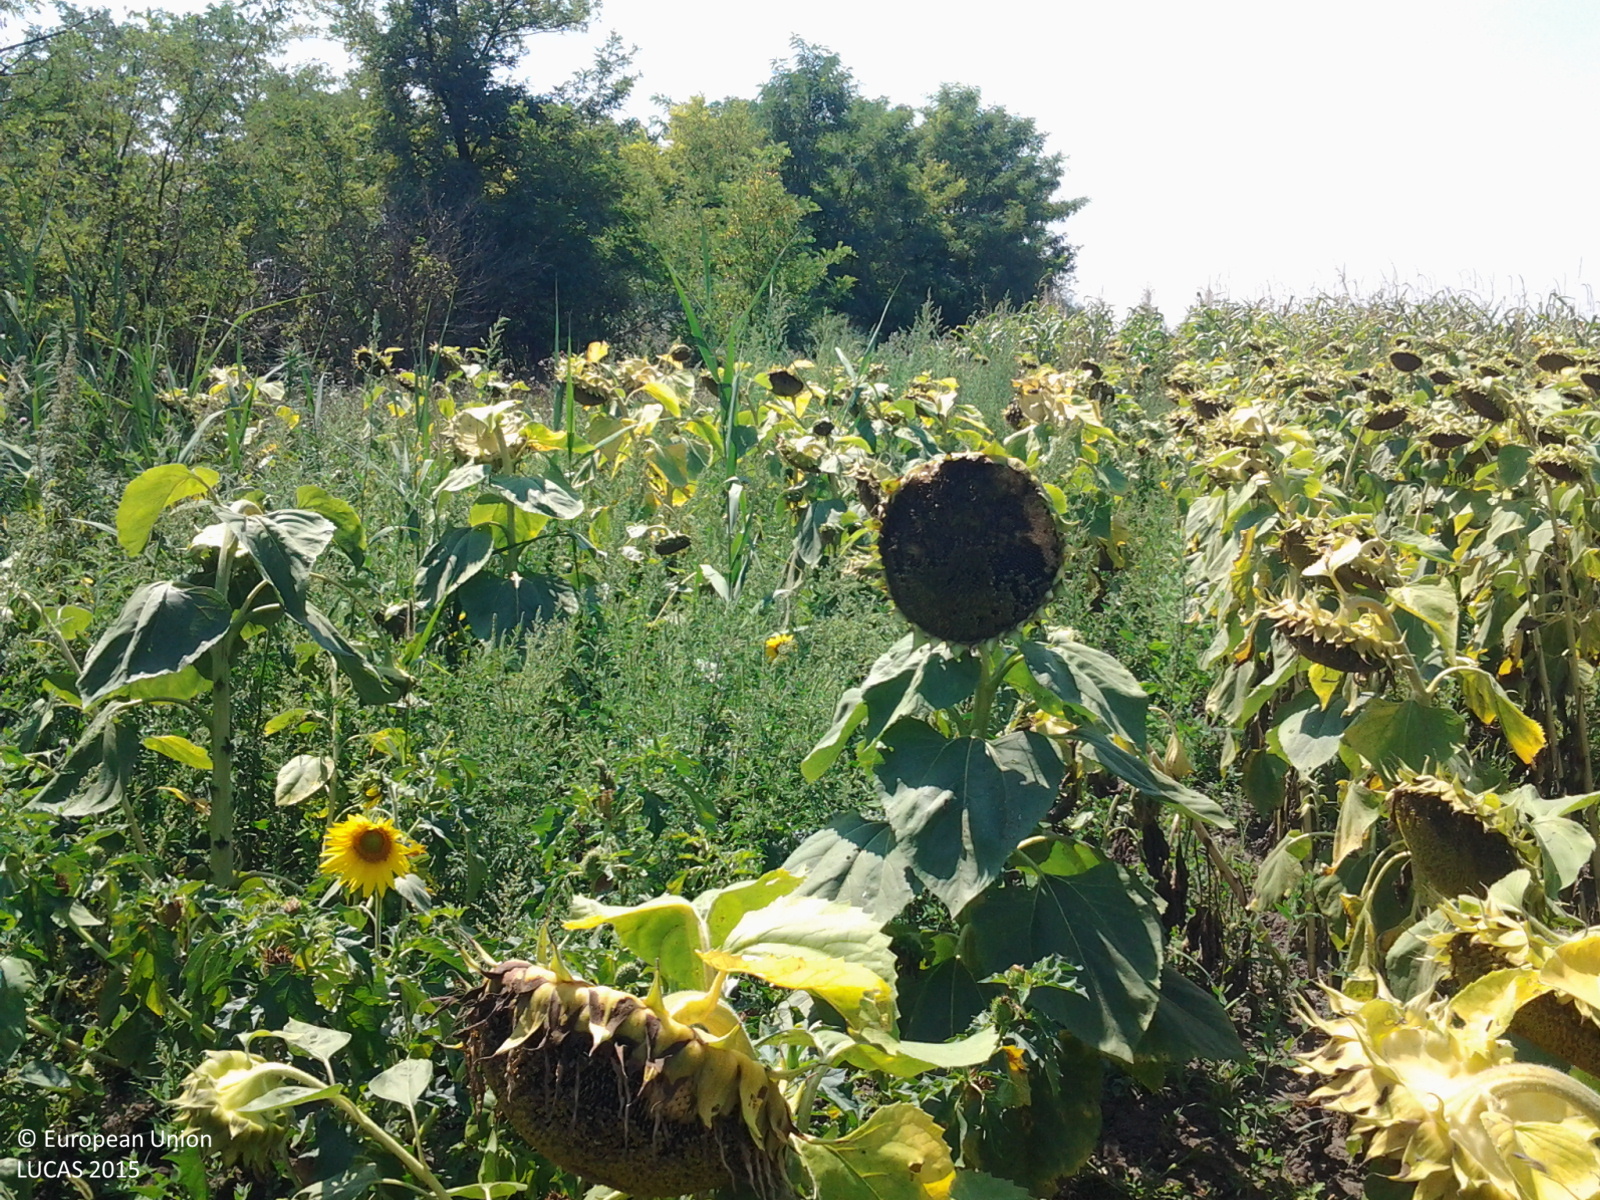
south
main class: Cropland
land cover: Sunflower
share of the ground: > 75 %
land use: Agriculture (excluding fallow land and kitchen gardens)
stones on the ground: < 10 %
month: August
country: HU
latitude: 47.2516
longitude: 19.8942
